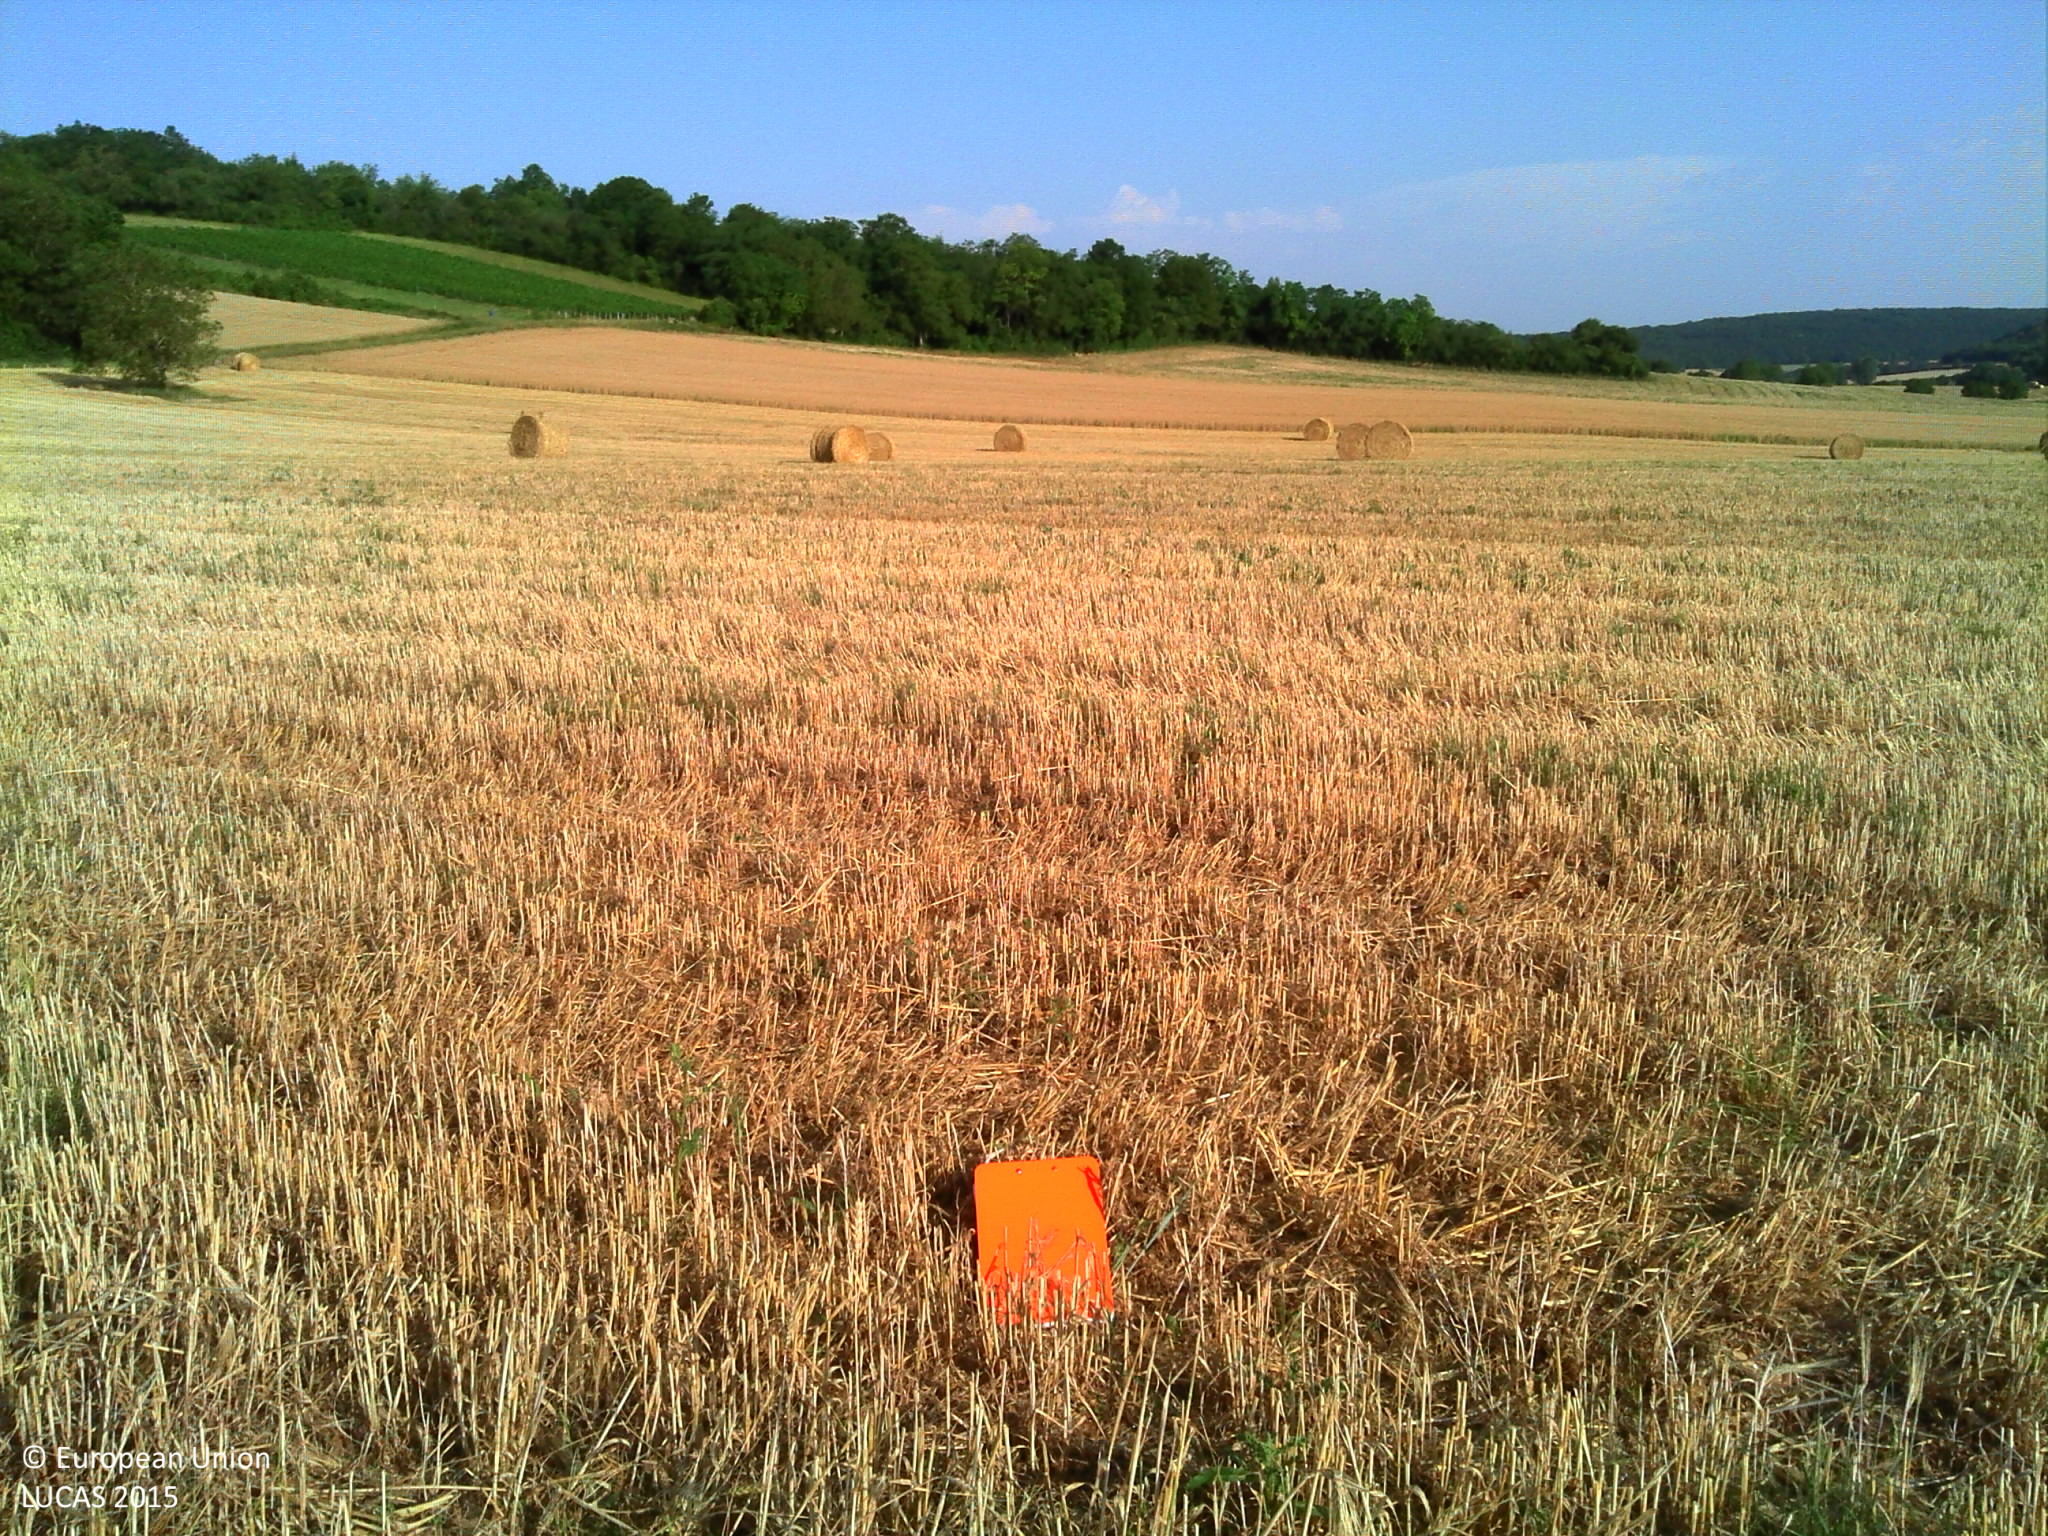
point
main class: Cropland
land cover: Barley
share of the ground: > 75 %
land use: Agriculture (excluding fallow land and kitchen gardens)
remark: Harvested field
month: July
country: FR
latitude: 47.2737
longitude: 3.5064
